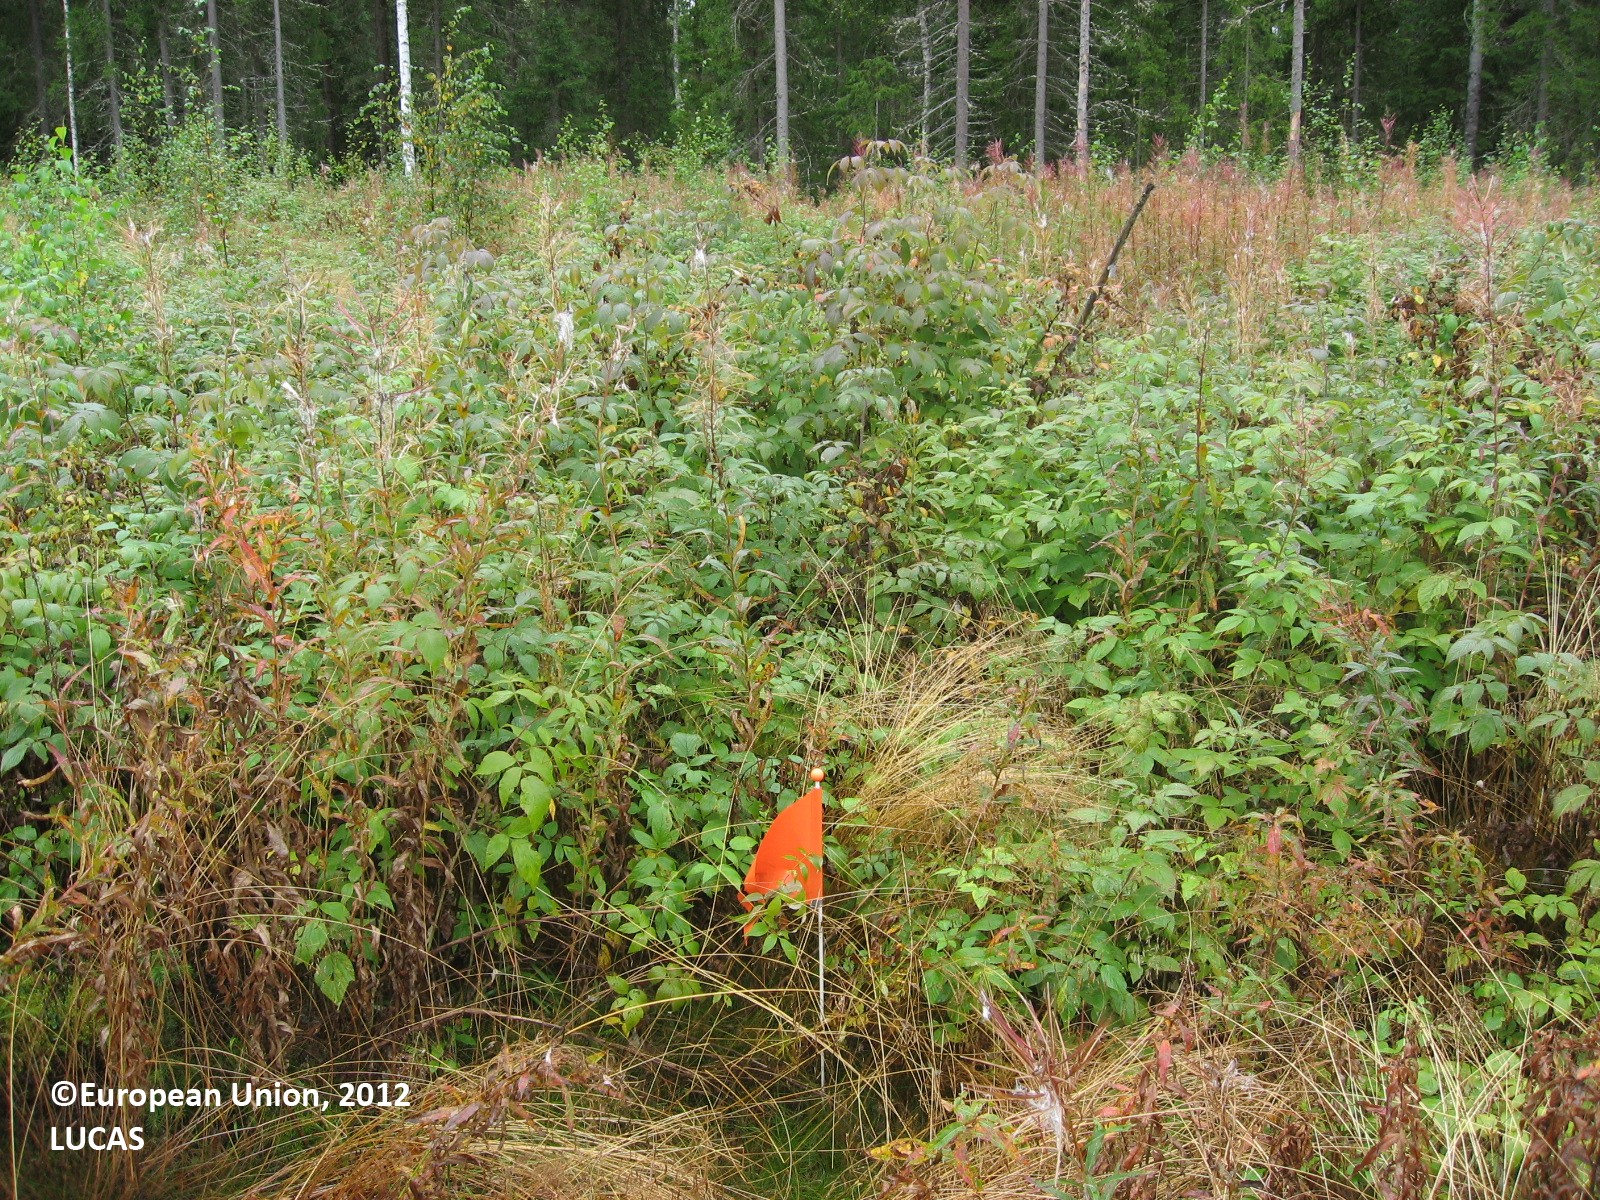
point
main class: Shrubland
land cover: Shrubland with sparse tree cover
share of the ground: > 75 %
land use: Forestry
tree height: < 5 m
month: August
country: FI
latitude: 61.4213
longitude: 24.7398
